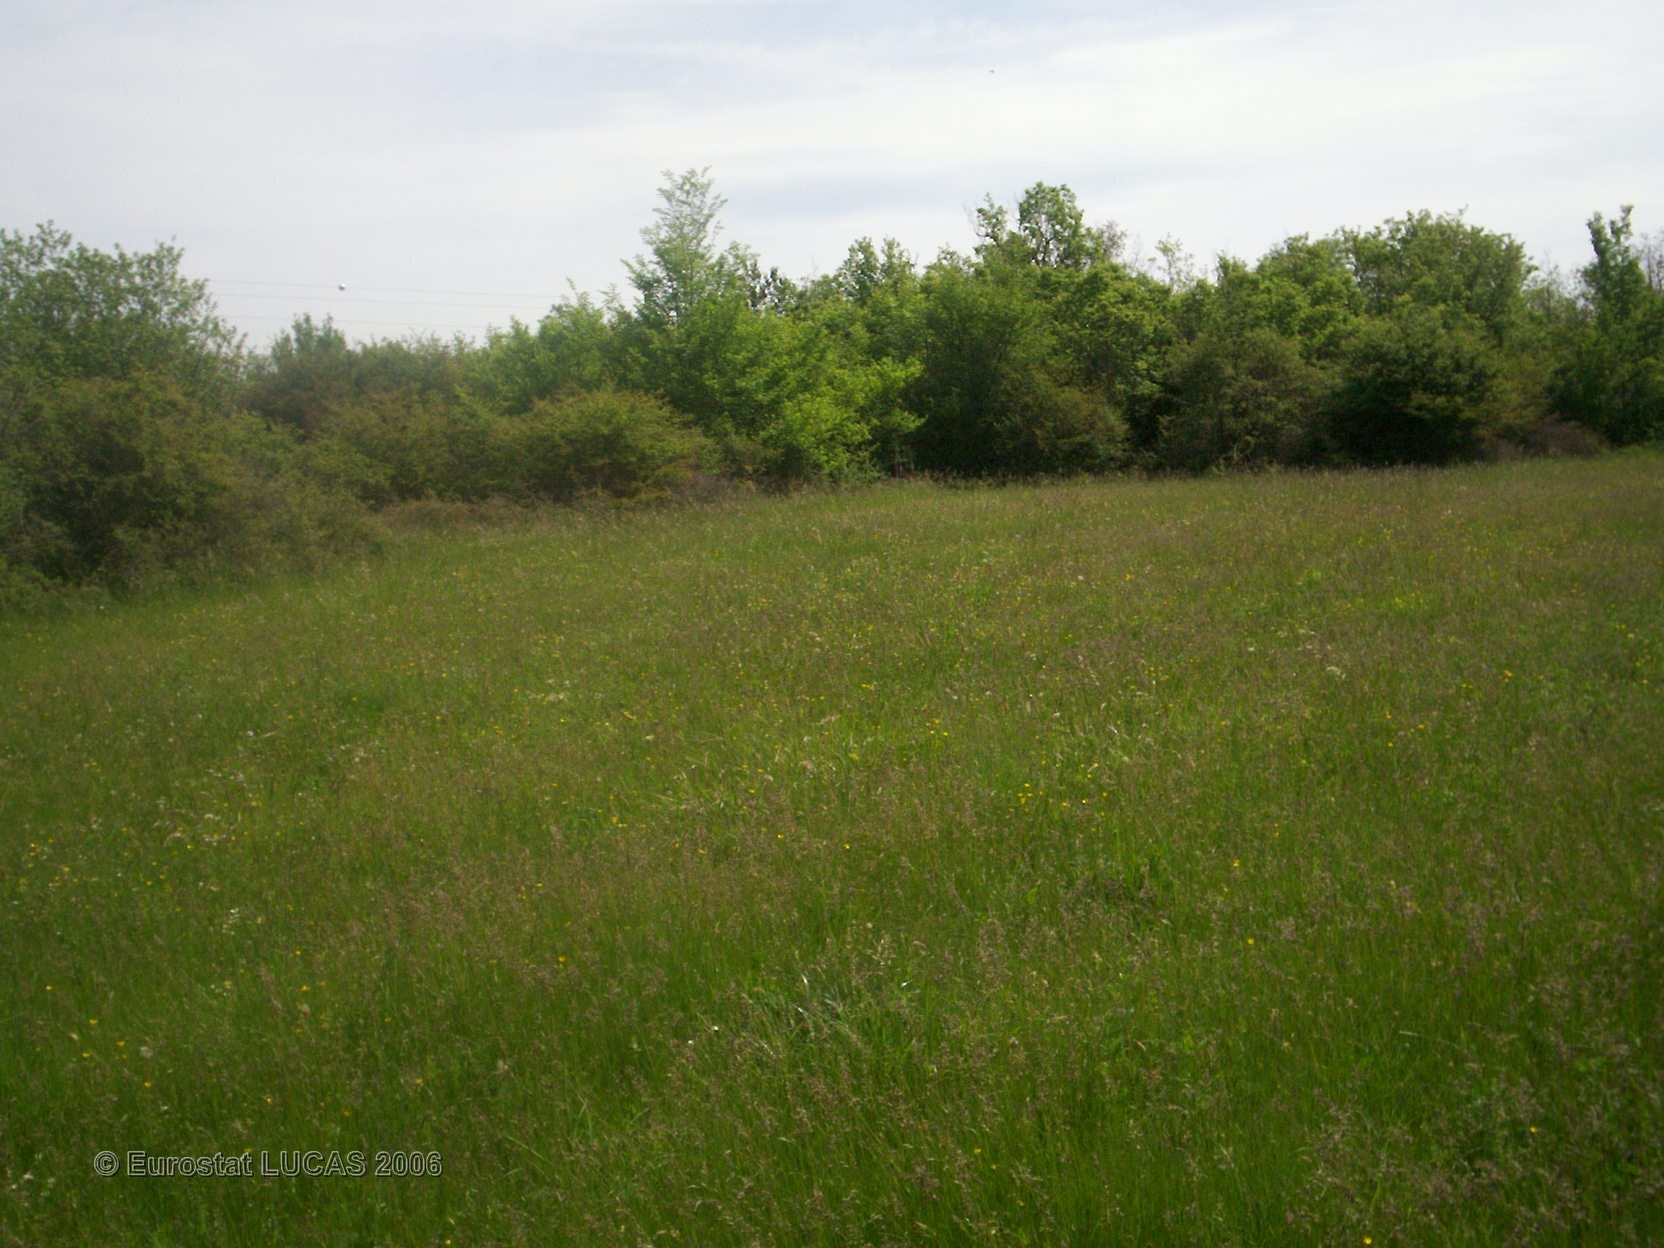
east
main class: Grassland
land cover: Grassland without tree/shrub cover
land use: Agriculture (excluding fallow land and kitchen gardens)
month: May
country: FR
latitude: 45.5040
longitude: 3.2306
